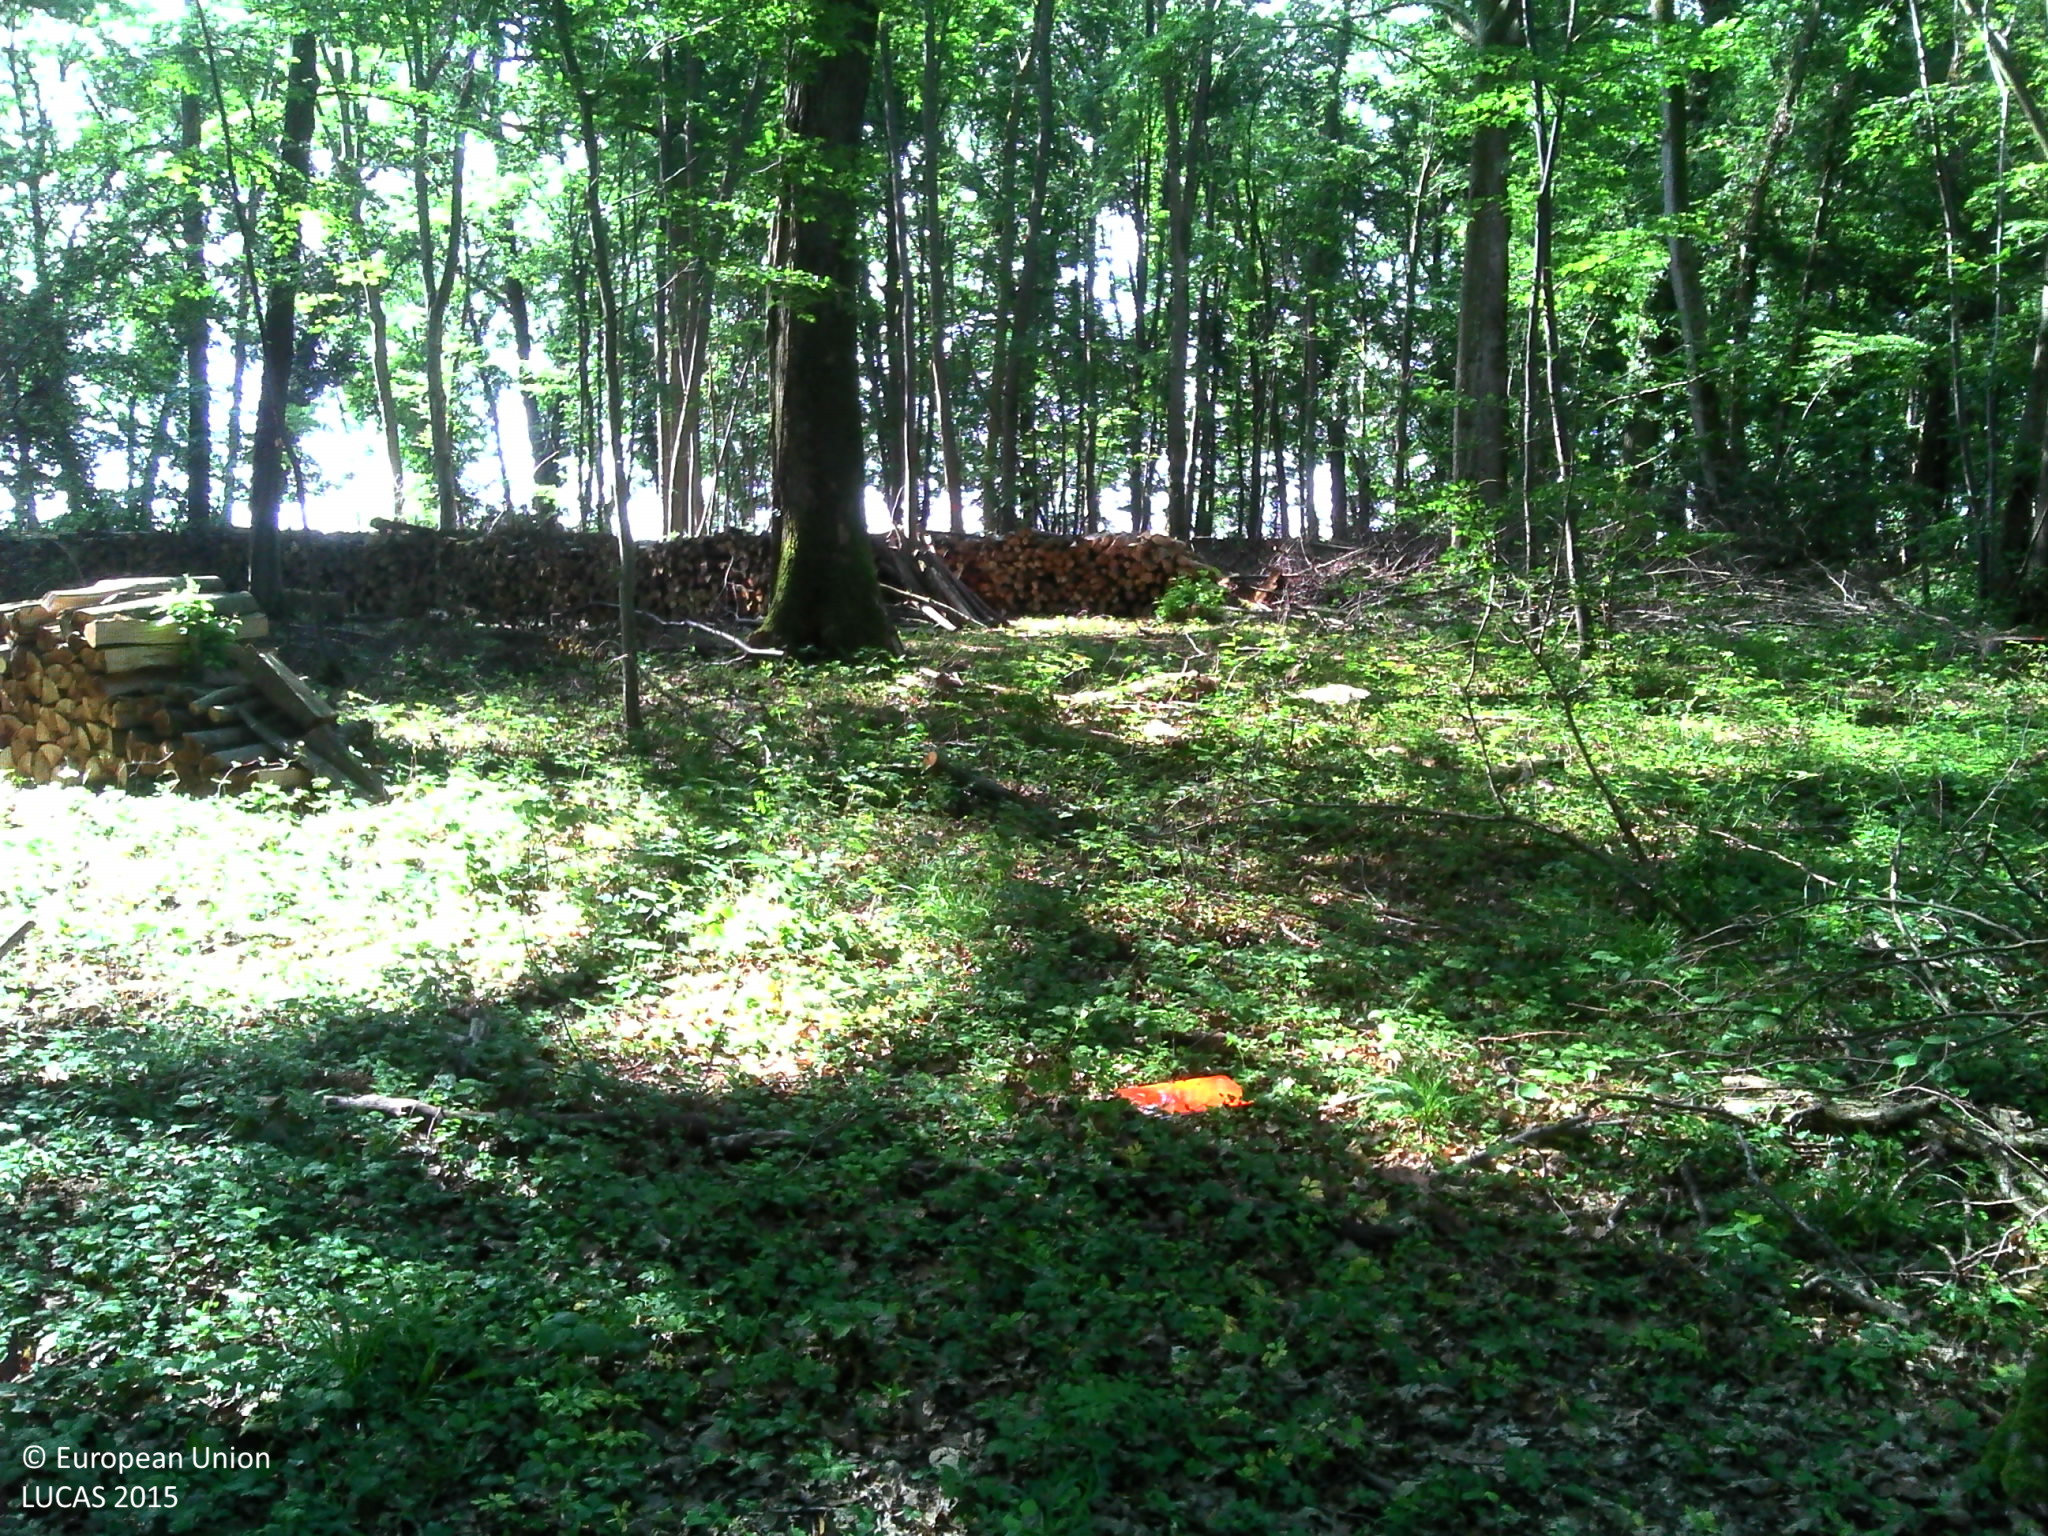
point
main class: Woodland
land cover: Broadleaved woodland
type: acidophilous oak and oak-birch forest
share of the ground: > 75 %
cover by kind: broadleaved forest trees 90 %, herbaceous plants 5 %, lichens and mosses 5 %
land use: Forestry
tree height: > 5 m
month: June
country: FR
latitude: 48.6897
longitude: 6.4819
